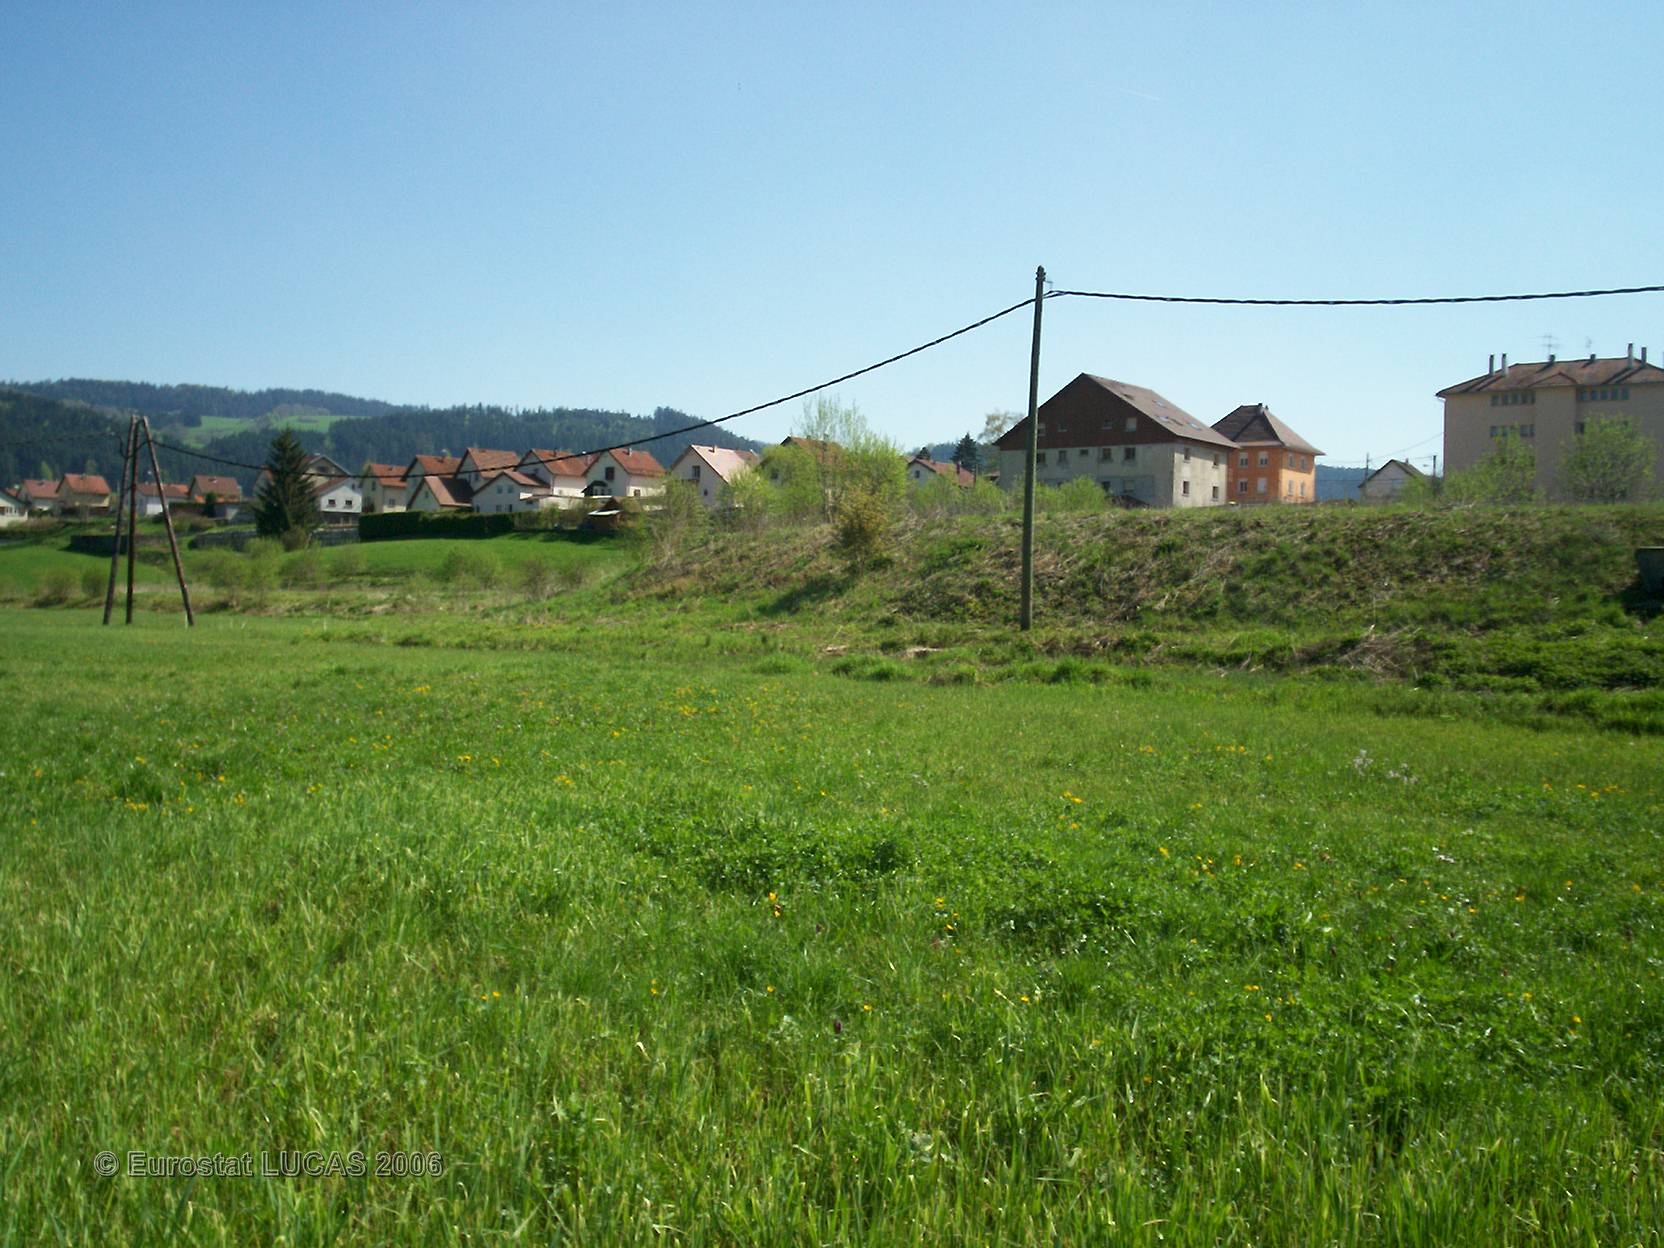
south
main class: Grassland
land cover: Grassland without tree/shrub cover
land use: Wetland
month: May
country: FR
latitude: 47.0548
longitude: 6.6189
